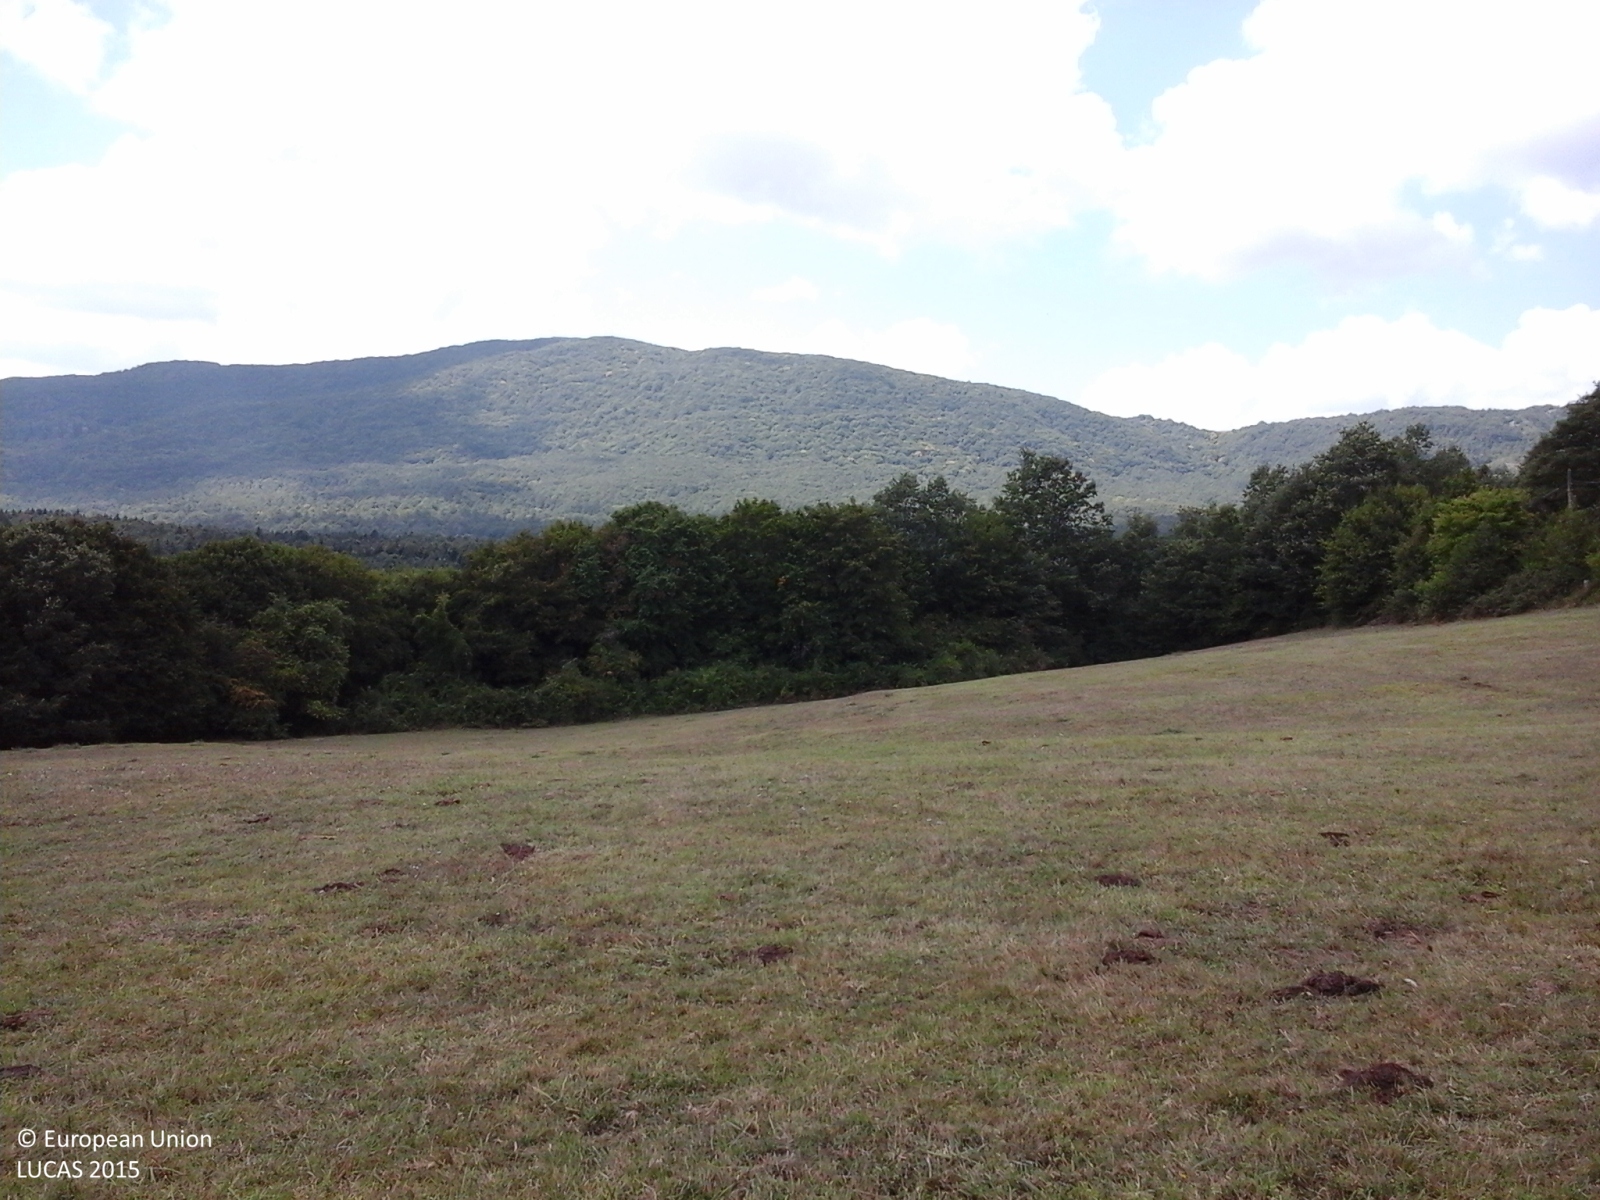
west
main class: Grassland
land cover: Grassland without tree/shrub cover
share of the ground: > 75 %
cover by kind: herbaceous plants 100 %
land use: Agriculture (excluding fallow land and kitchen gardens)
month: August
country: IT
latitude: 41.7707
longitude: 14.2079
